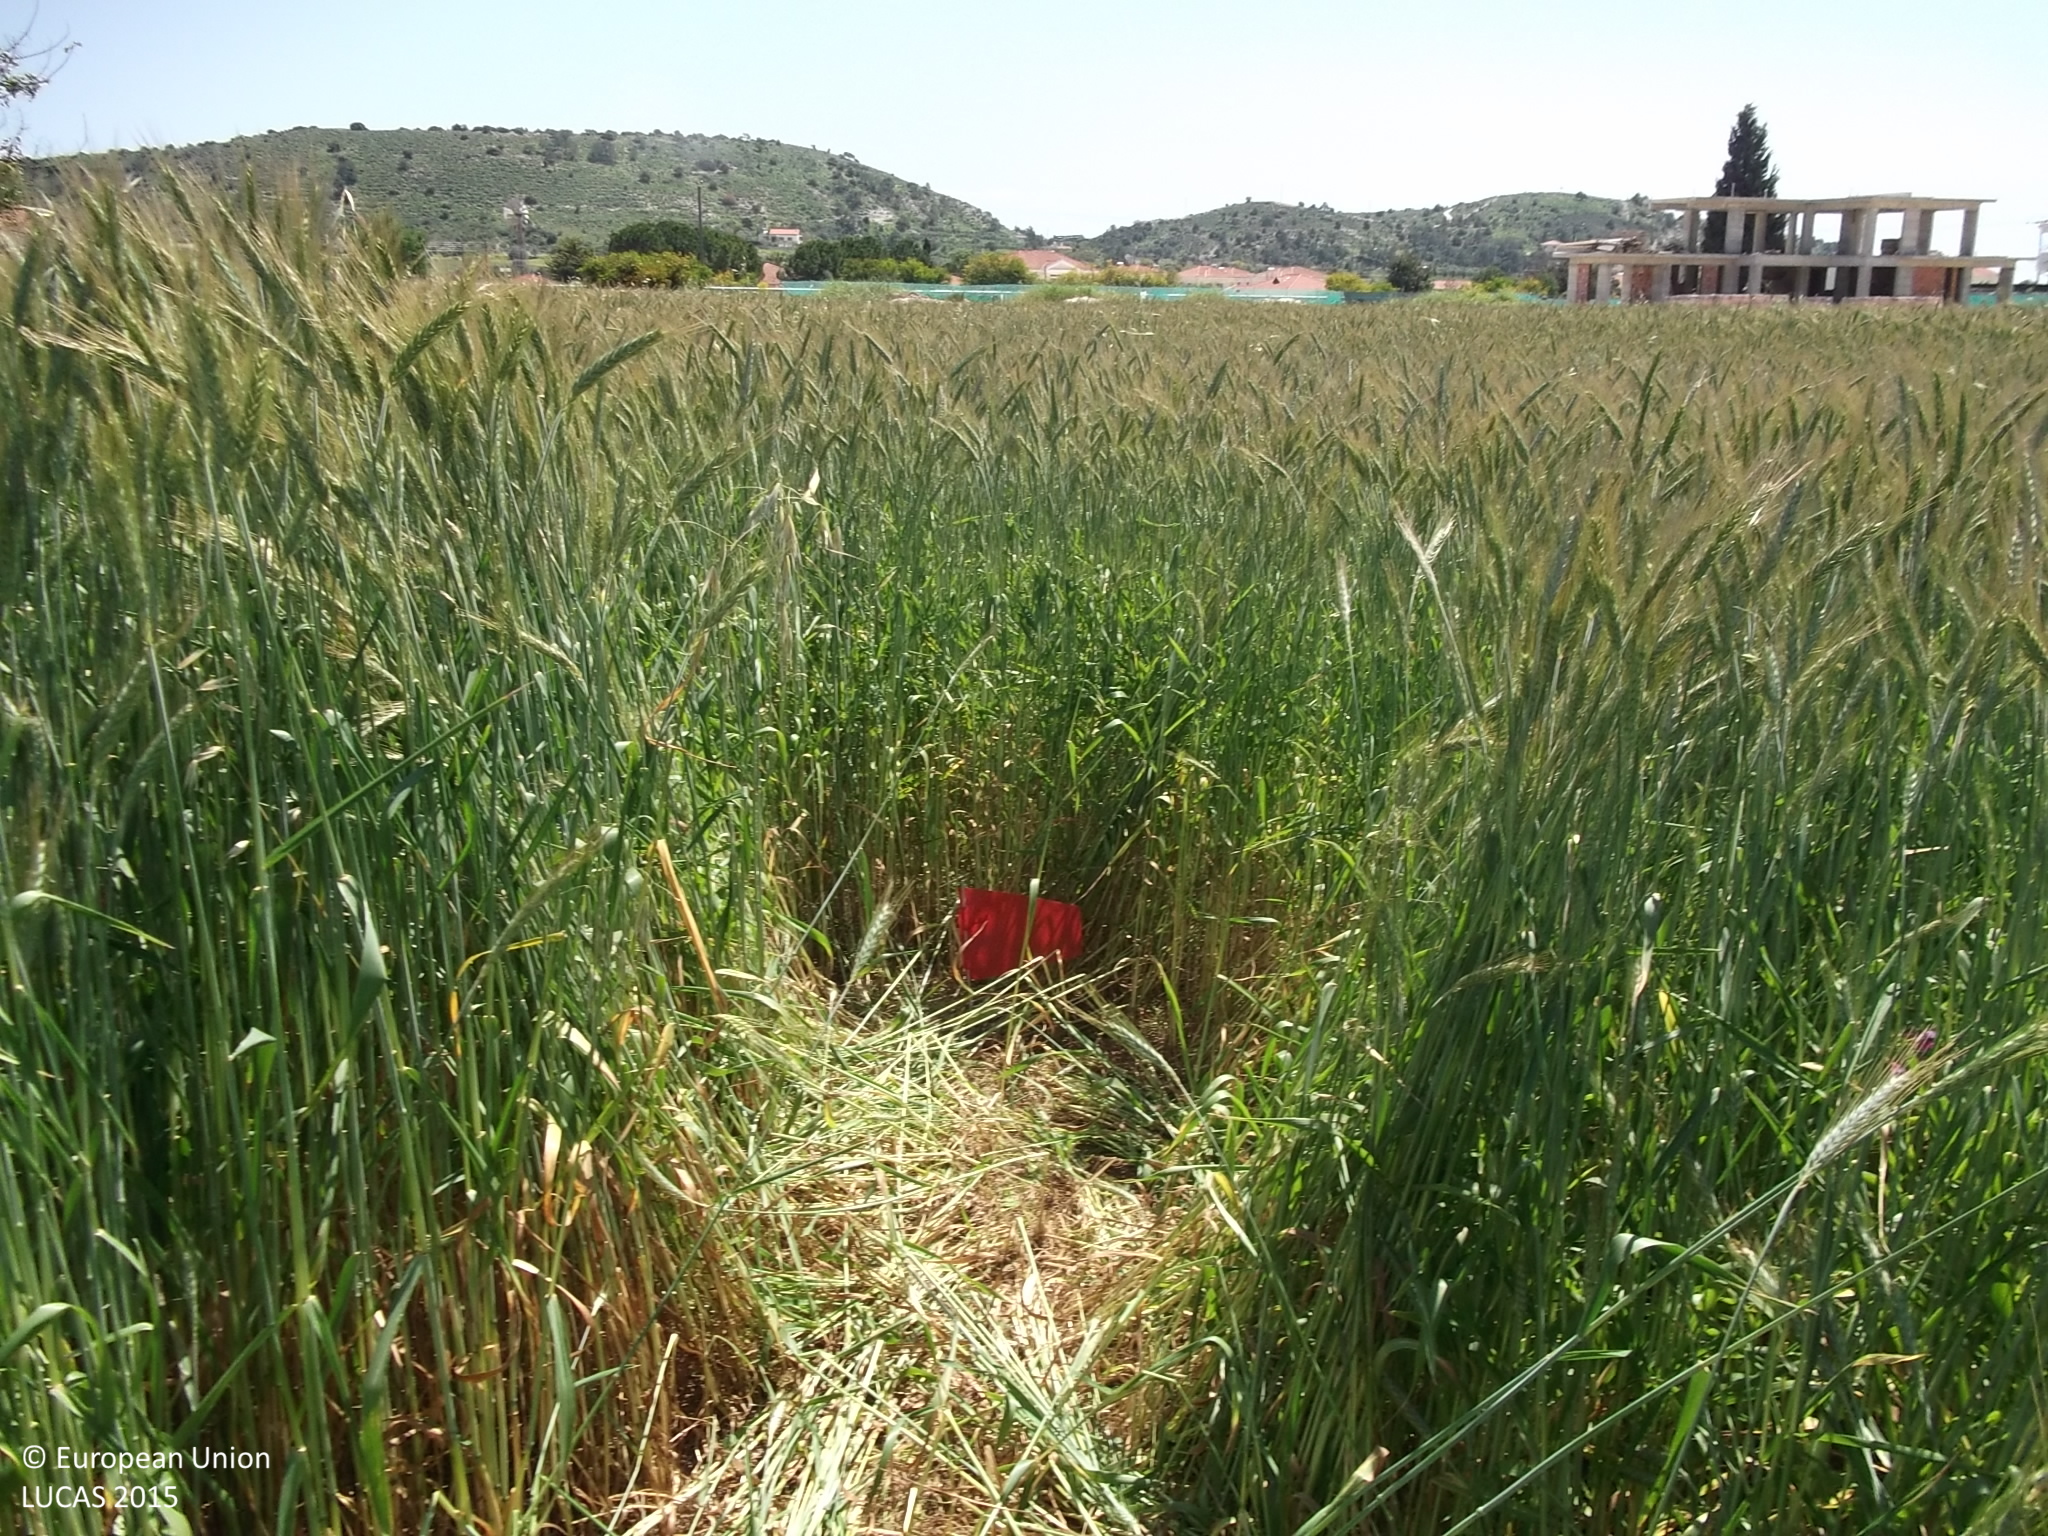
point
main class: Cropland
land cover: Common wheat
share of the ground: > 75 %
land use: Agriculture (excluding fallow land and kitchen gardens)
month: April
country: CY
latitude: 34.8706
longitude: 33.5018
